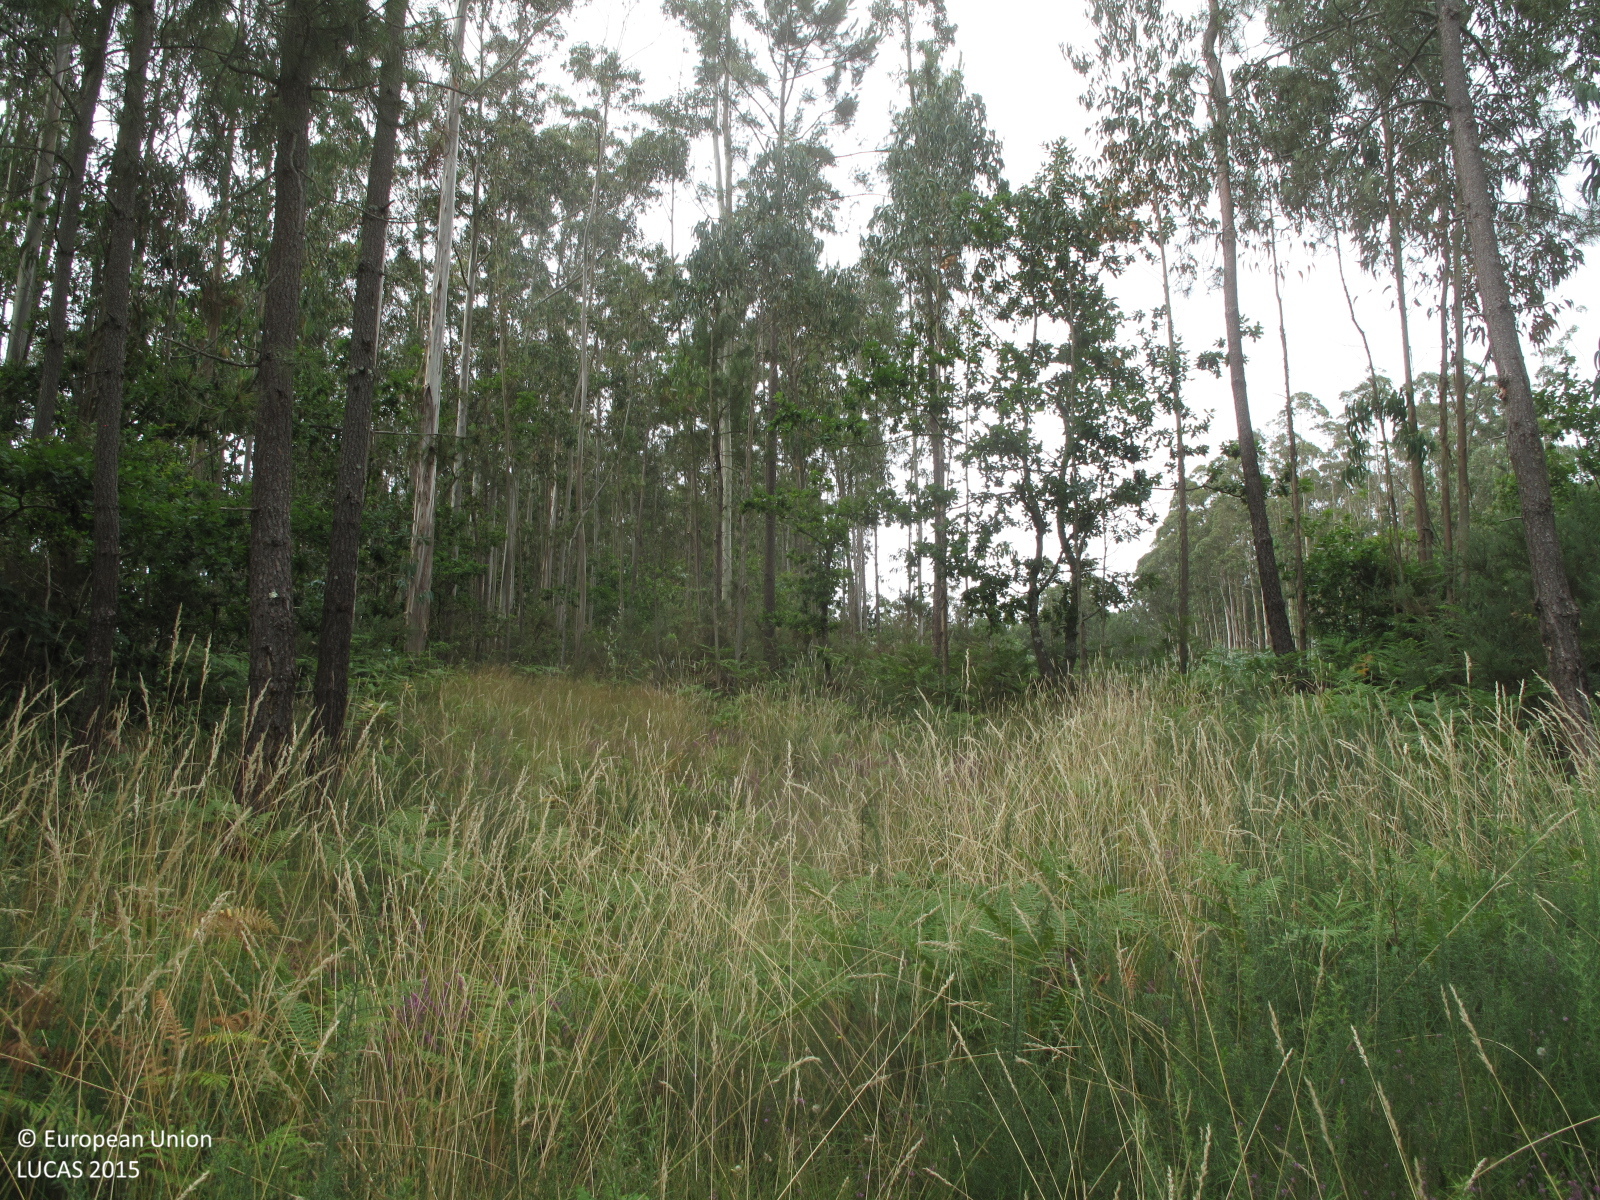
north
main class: Woodland
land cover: Broadleaved woodland
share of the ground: 50 - 75 %
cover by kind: broadleaved forest trees 50 %, shrubs 40 %, herbaceous plants 10 %
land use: Forestry
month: July
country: ES
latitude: 43.2210
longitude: -8.2083
